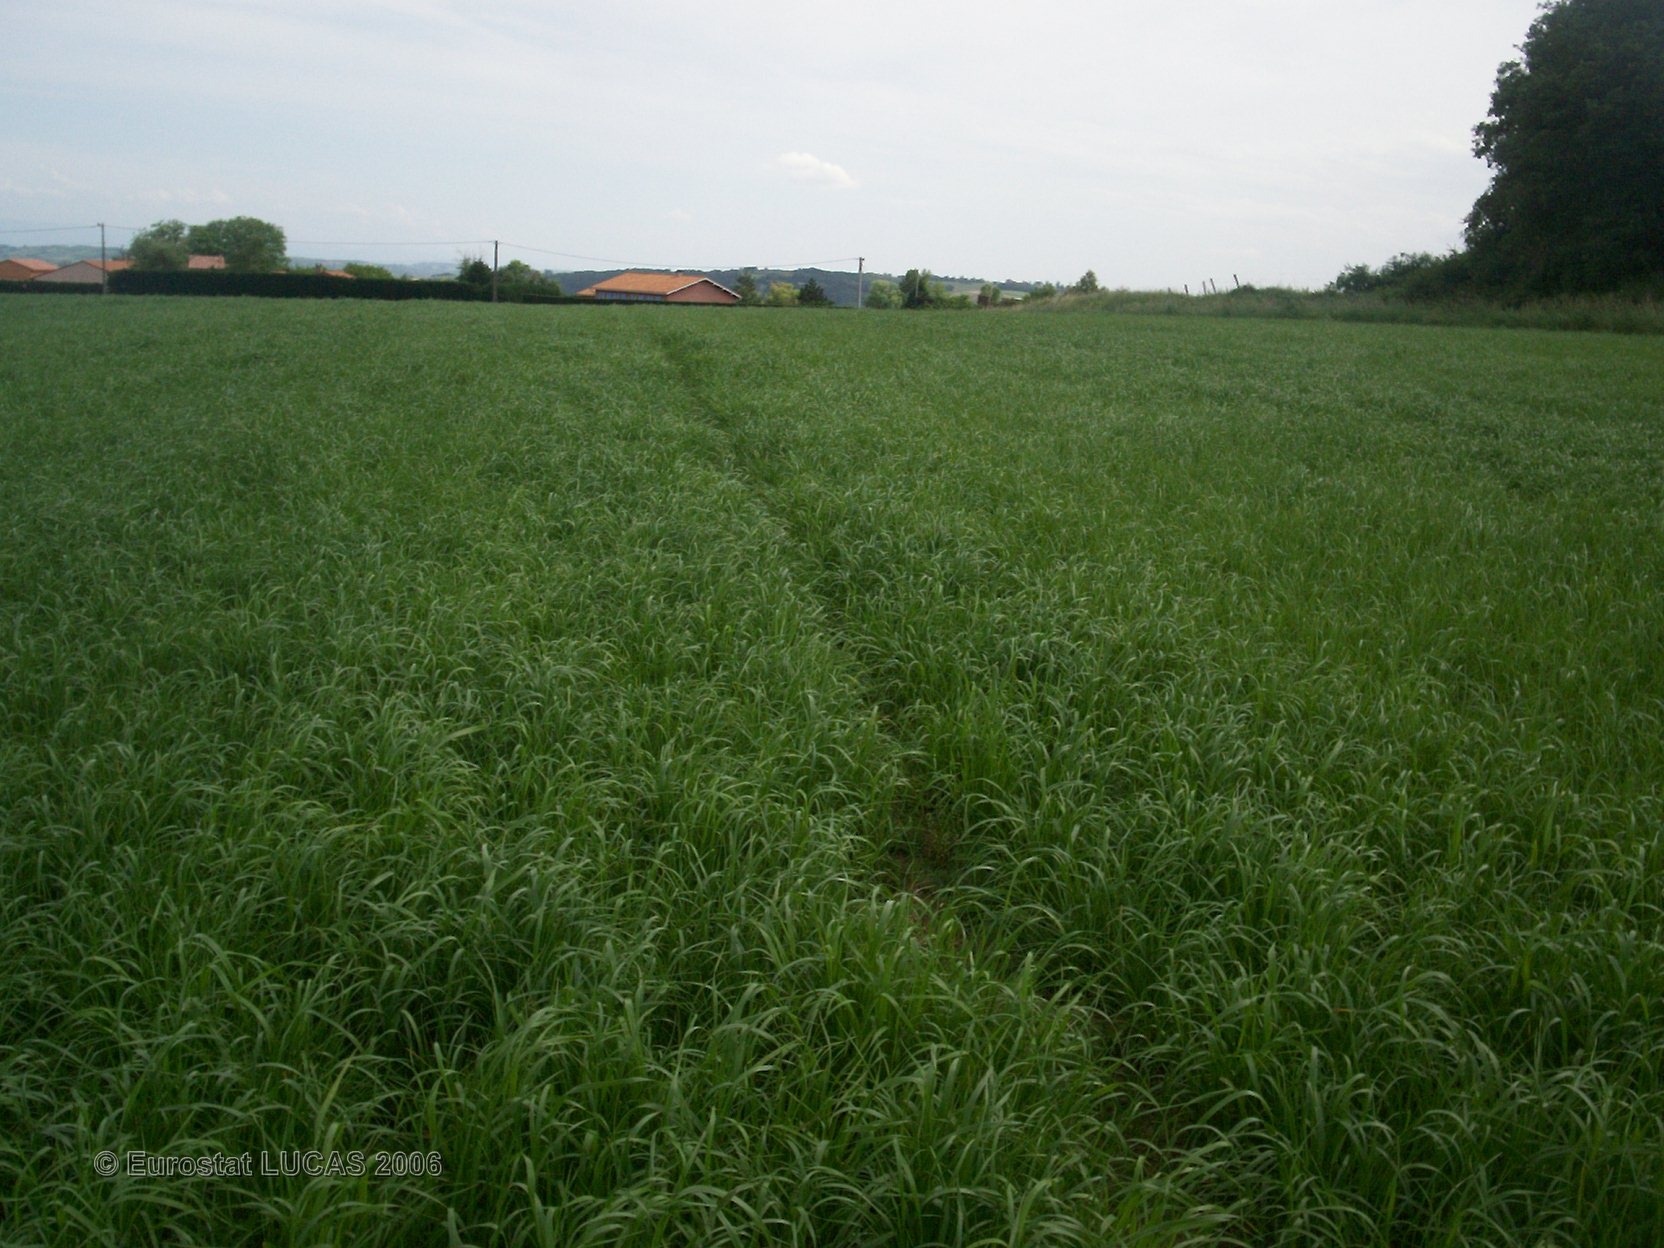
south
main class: Grassland
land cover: Grassland without tree/shrub cover
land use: Agriculture (excluding fallow land and kitchen gardens)
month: May
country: FR
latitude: 45.2663
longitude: 4.7665
